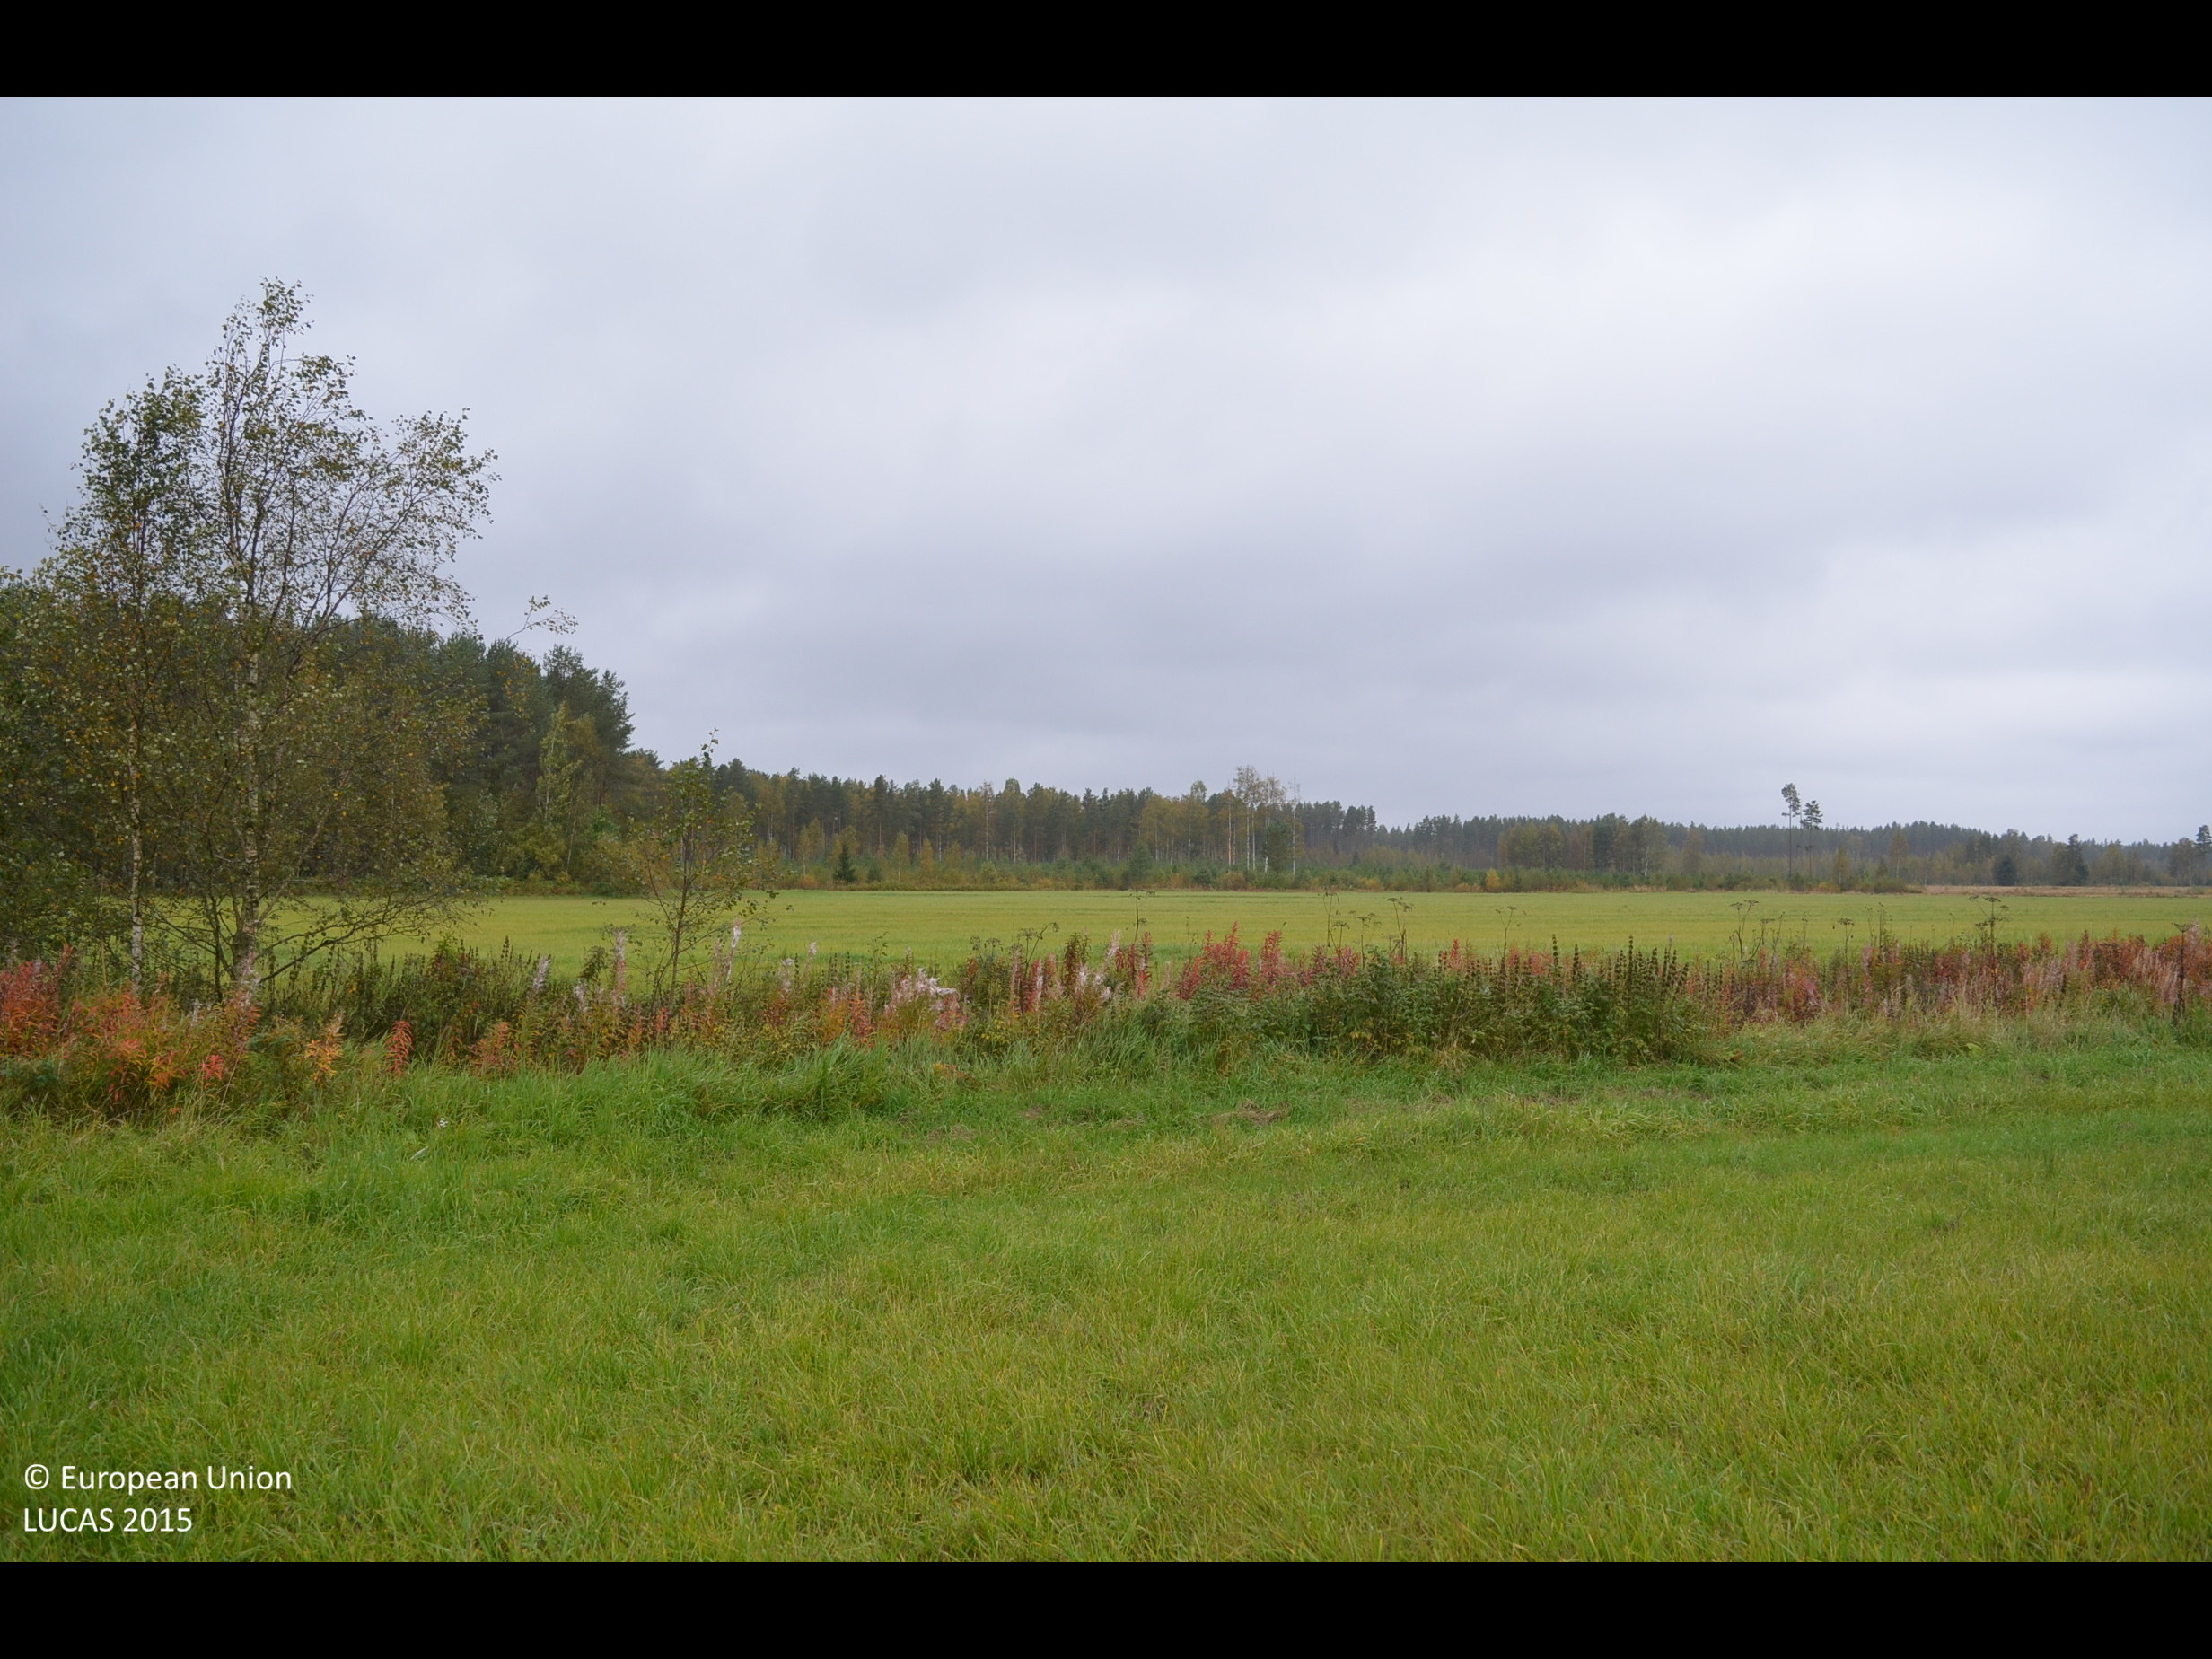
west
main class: Cropland
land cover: Temporary grasslands
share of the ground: > 75 %
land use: Agriculture (excluding fallow land and kitchen gardens)
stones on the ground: < 10 %
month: September
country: FI
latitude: 62.9347
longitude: 23.7229
